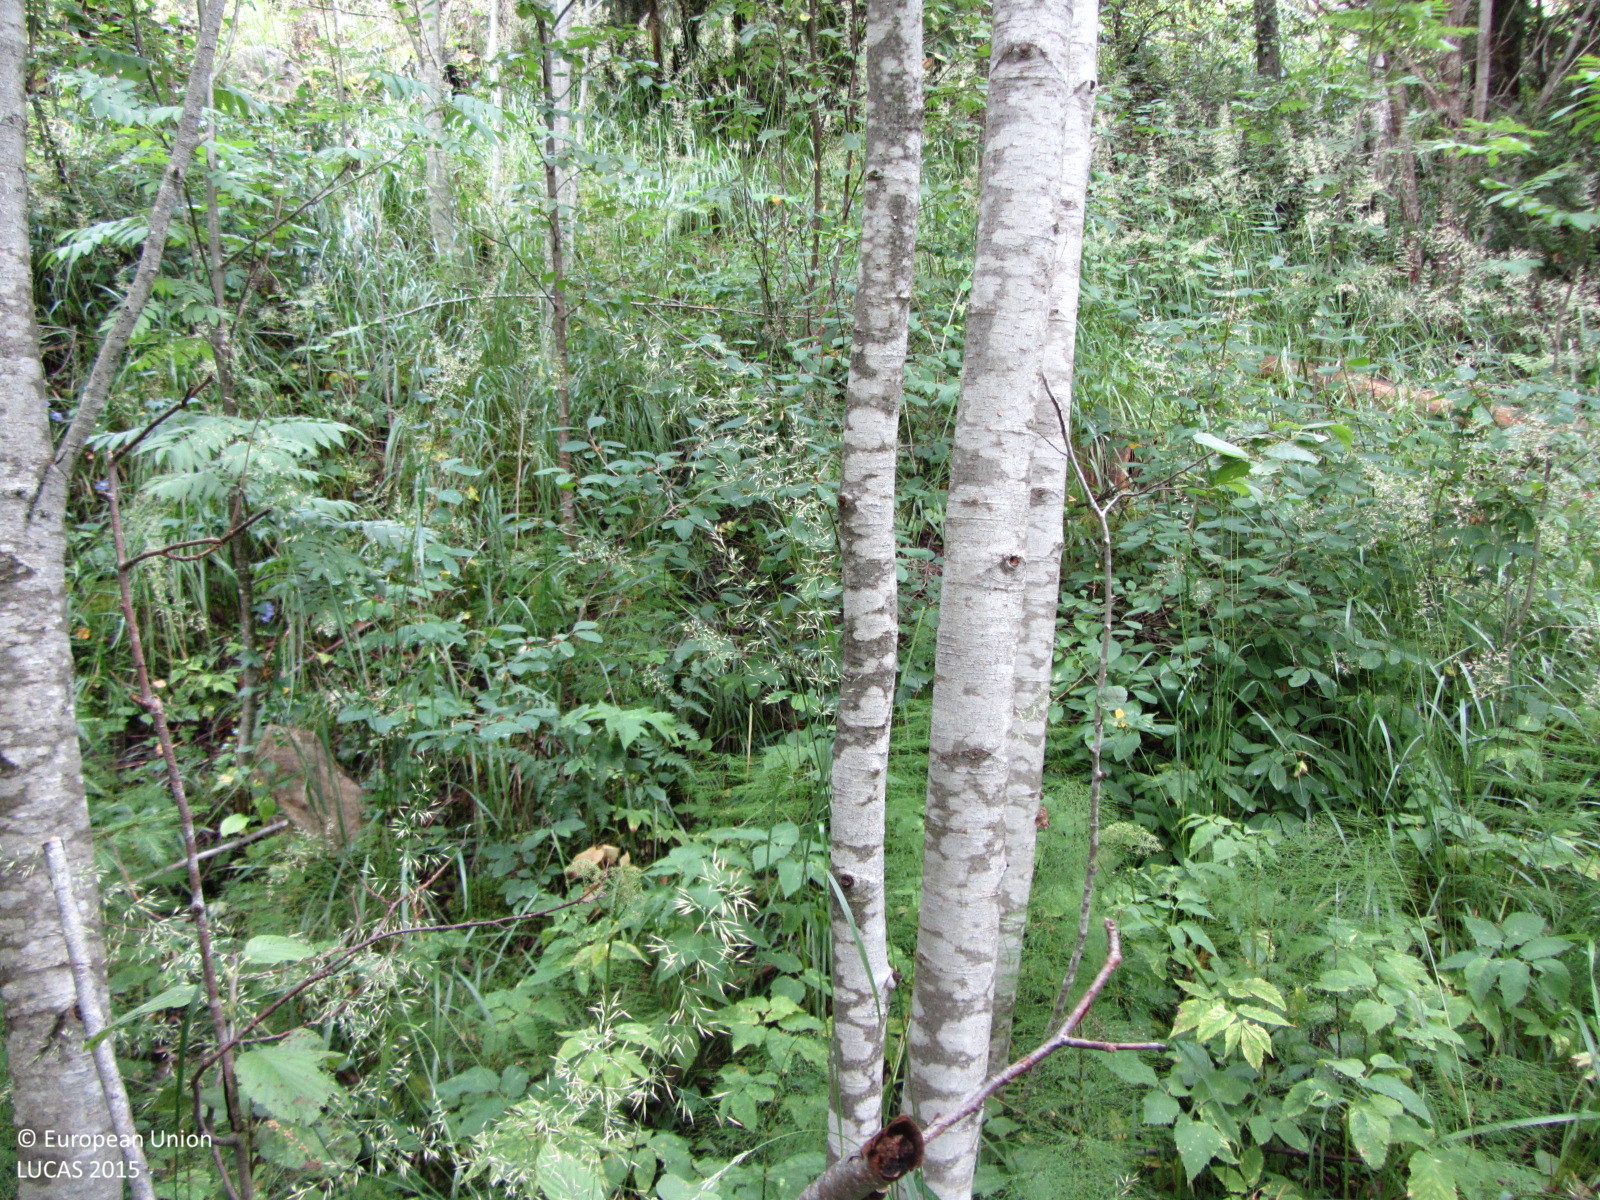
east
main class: Woodland
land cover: Broadleaved woodland
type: boreal forest
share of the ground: > 75 %
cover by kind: broadleaved forest trees 85 %, herbaceous plants 10 %, coniferous forest trees 5 %
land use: Forestry
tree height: > 5 m
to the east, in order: Broadleaved woodland; Spruce dominated mixed woodland; Spruce dominated coniferous woodland
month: July
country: FI
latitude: 60.4730
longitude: 24.3092
